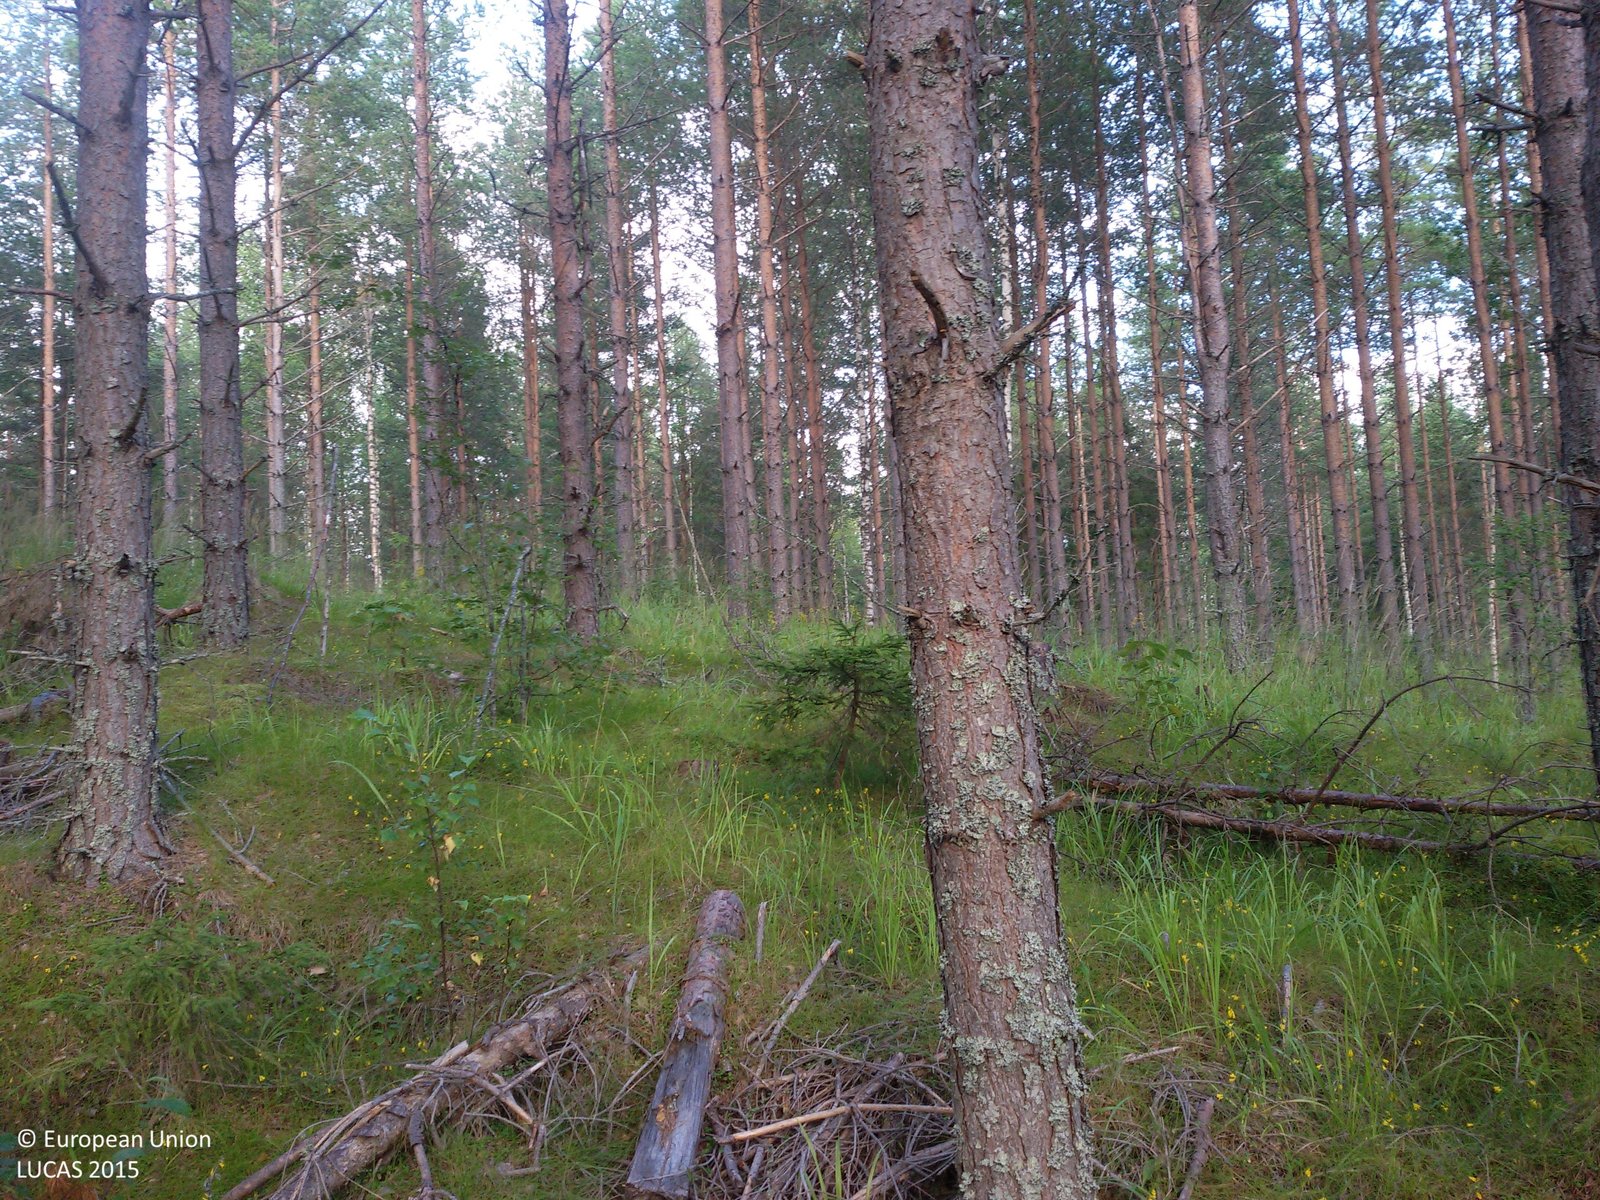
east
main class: Woodland
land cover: Pine dominated coniferous woodland
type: boreal forest
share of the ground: 50 - 75 %
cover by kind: coniferous forest trees 60 %, herbaceous plants 25 %, lichens and mosses 10 %, broadleaved forest trees 5 %
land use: Forestry
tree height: > 5 m
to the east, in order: Pine dominated coniferous woodland; Pine dominated mixed woodland; Paved roads, cycling and walking lanes; Pine dominated mixed woodland; Pine dominated coniferous woodland
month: August
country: SE
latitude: 60.8433
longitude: 16.5192
